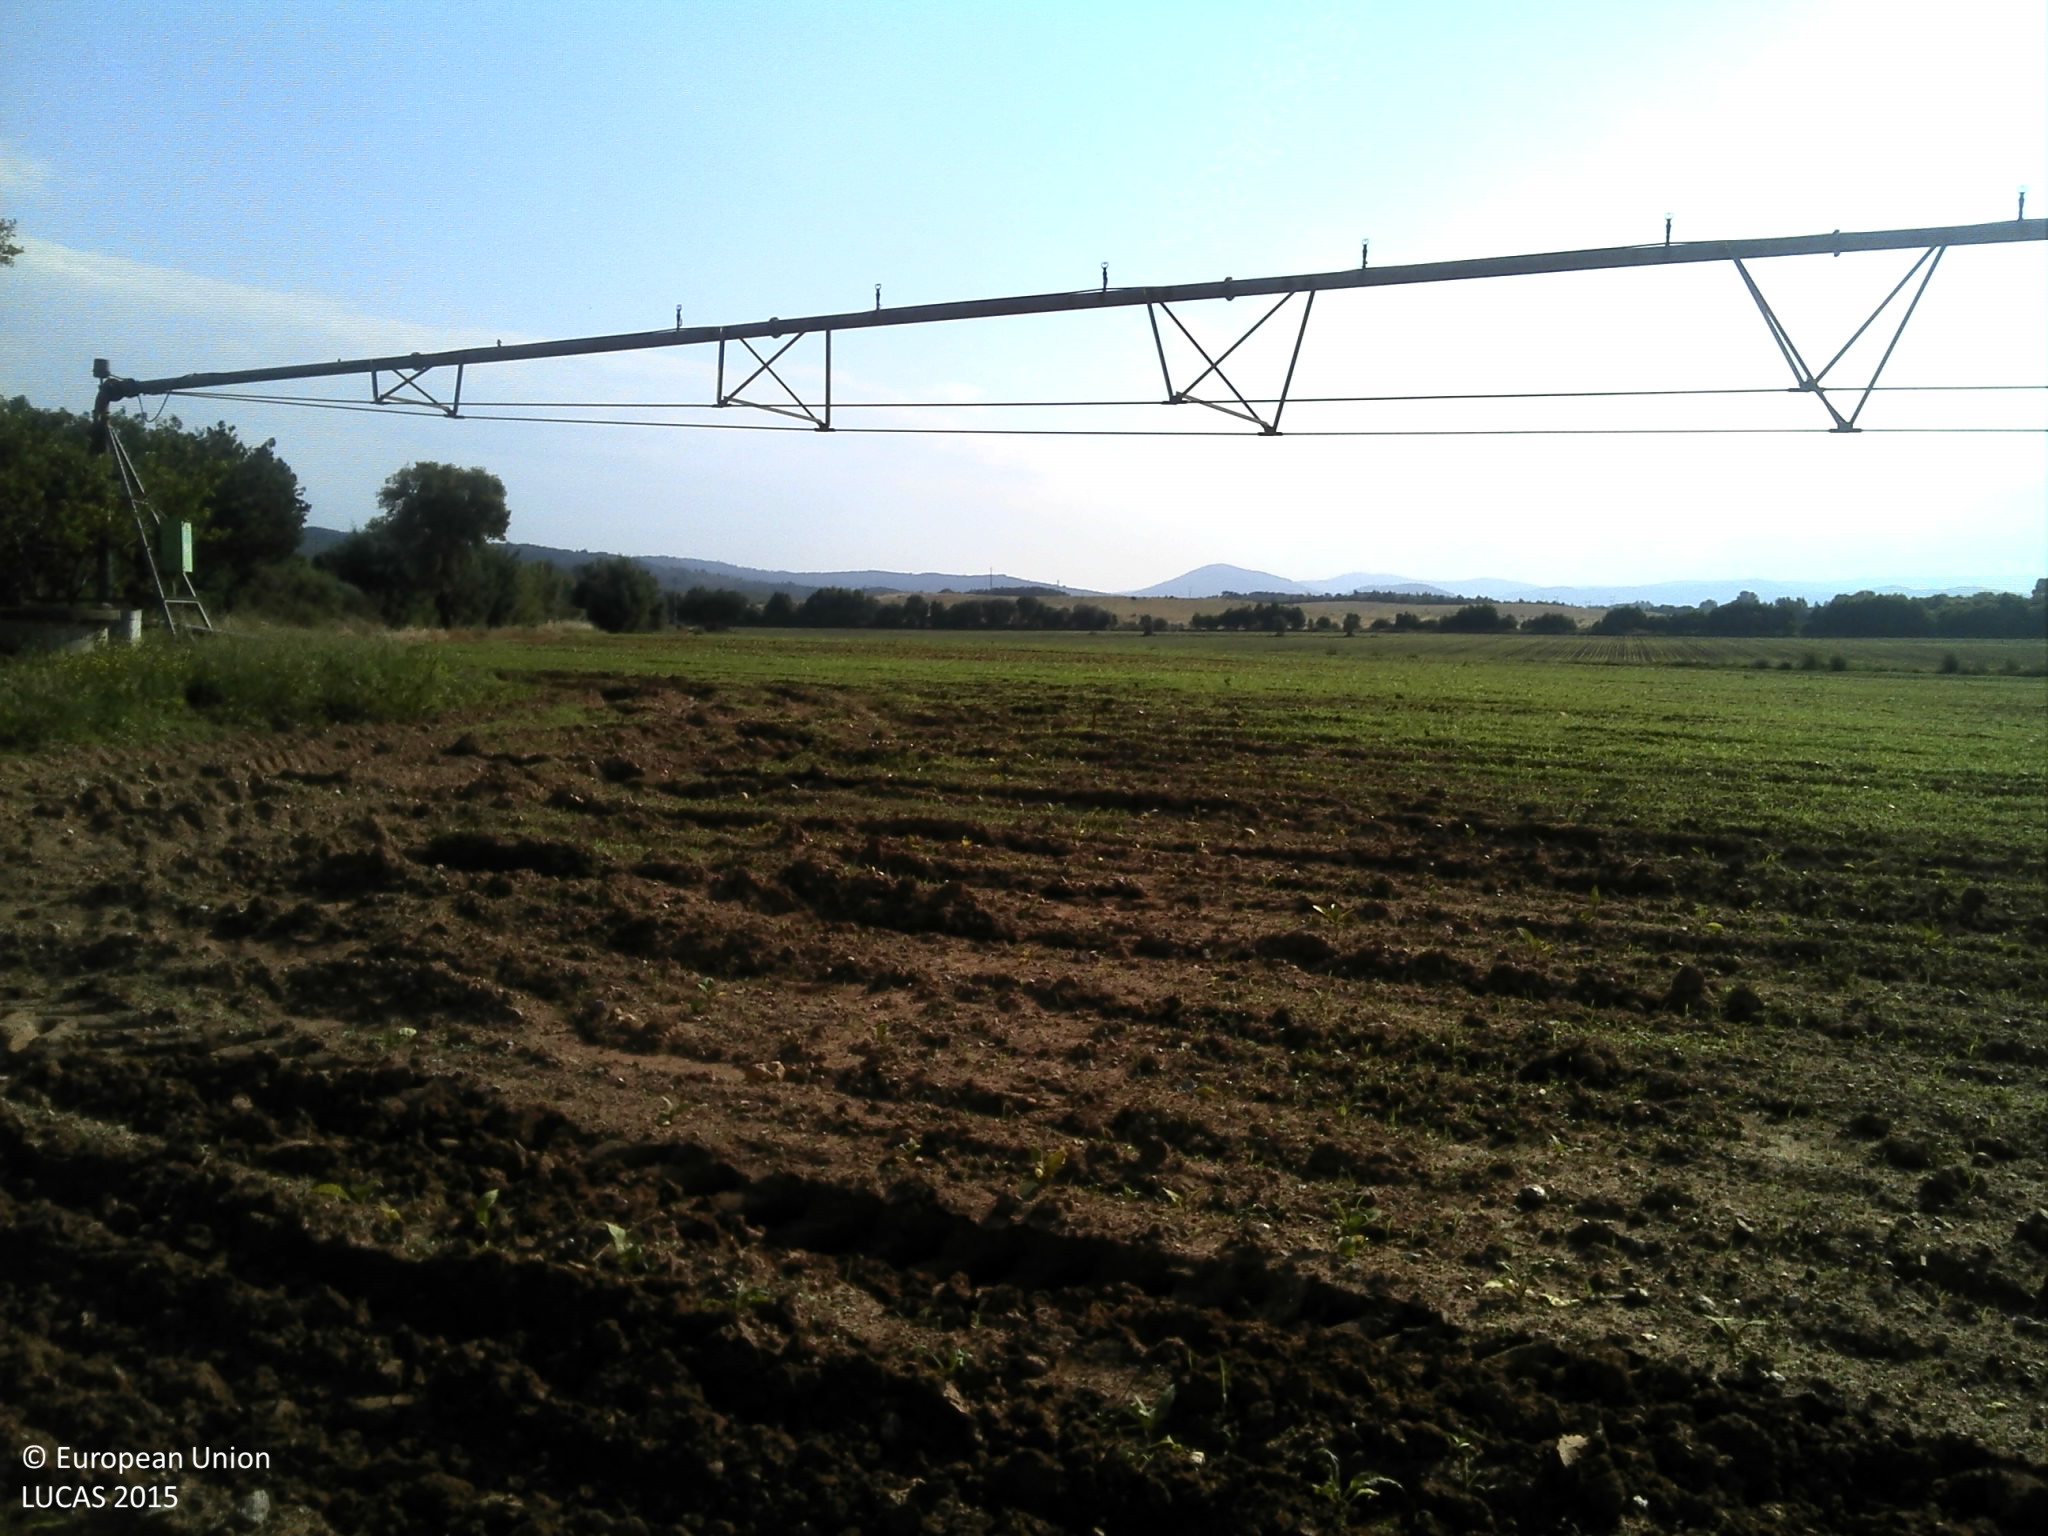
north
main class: Cropland
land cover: Tobacco
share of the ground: < 10 %
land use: Agriculture (excluding fallow land and kitchen gardens)
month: June
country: PT
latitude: 40.2051
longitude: -7.3369
